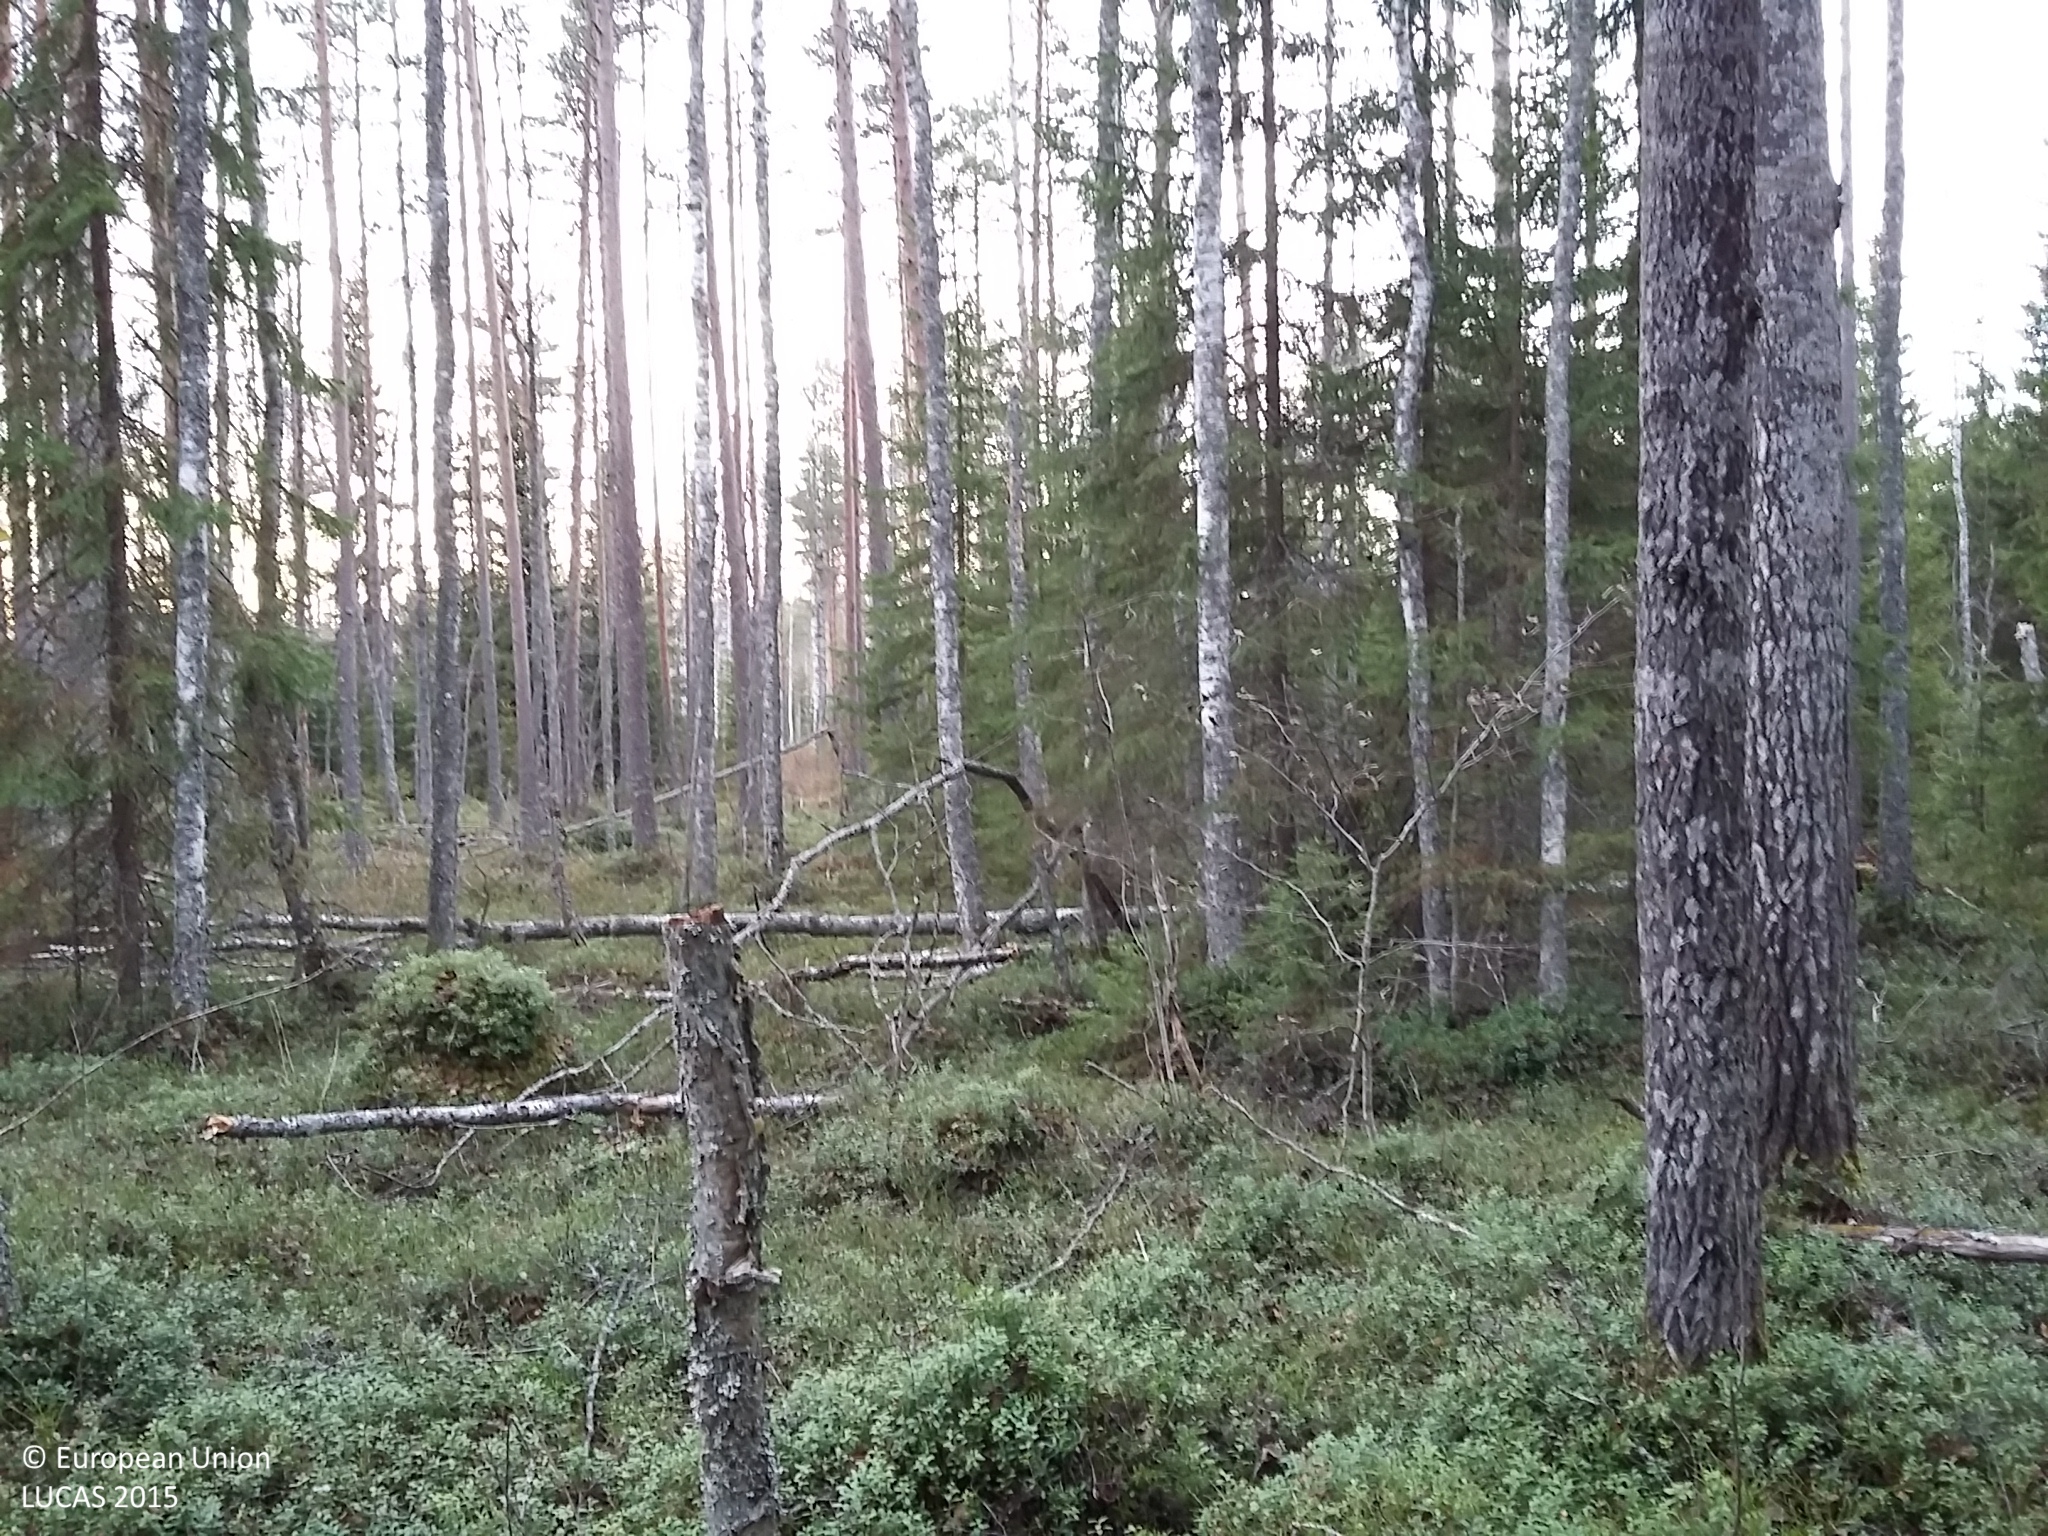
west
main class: Woodland
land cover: Spruce dominated mixed woodland
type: boreal forest
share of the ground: > 75 %
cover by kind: coniferous forest trees 45 %, broadleaved forest trees 35 %, shrubs 10 %, herbaceous plants 5 %, lichens and mosses 5 %
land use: Forestry
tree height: > 5 m
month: October
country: FI
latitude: 64.0510
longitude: 24.9749
